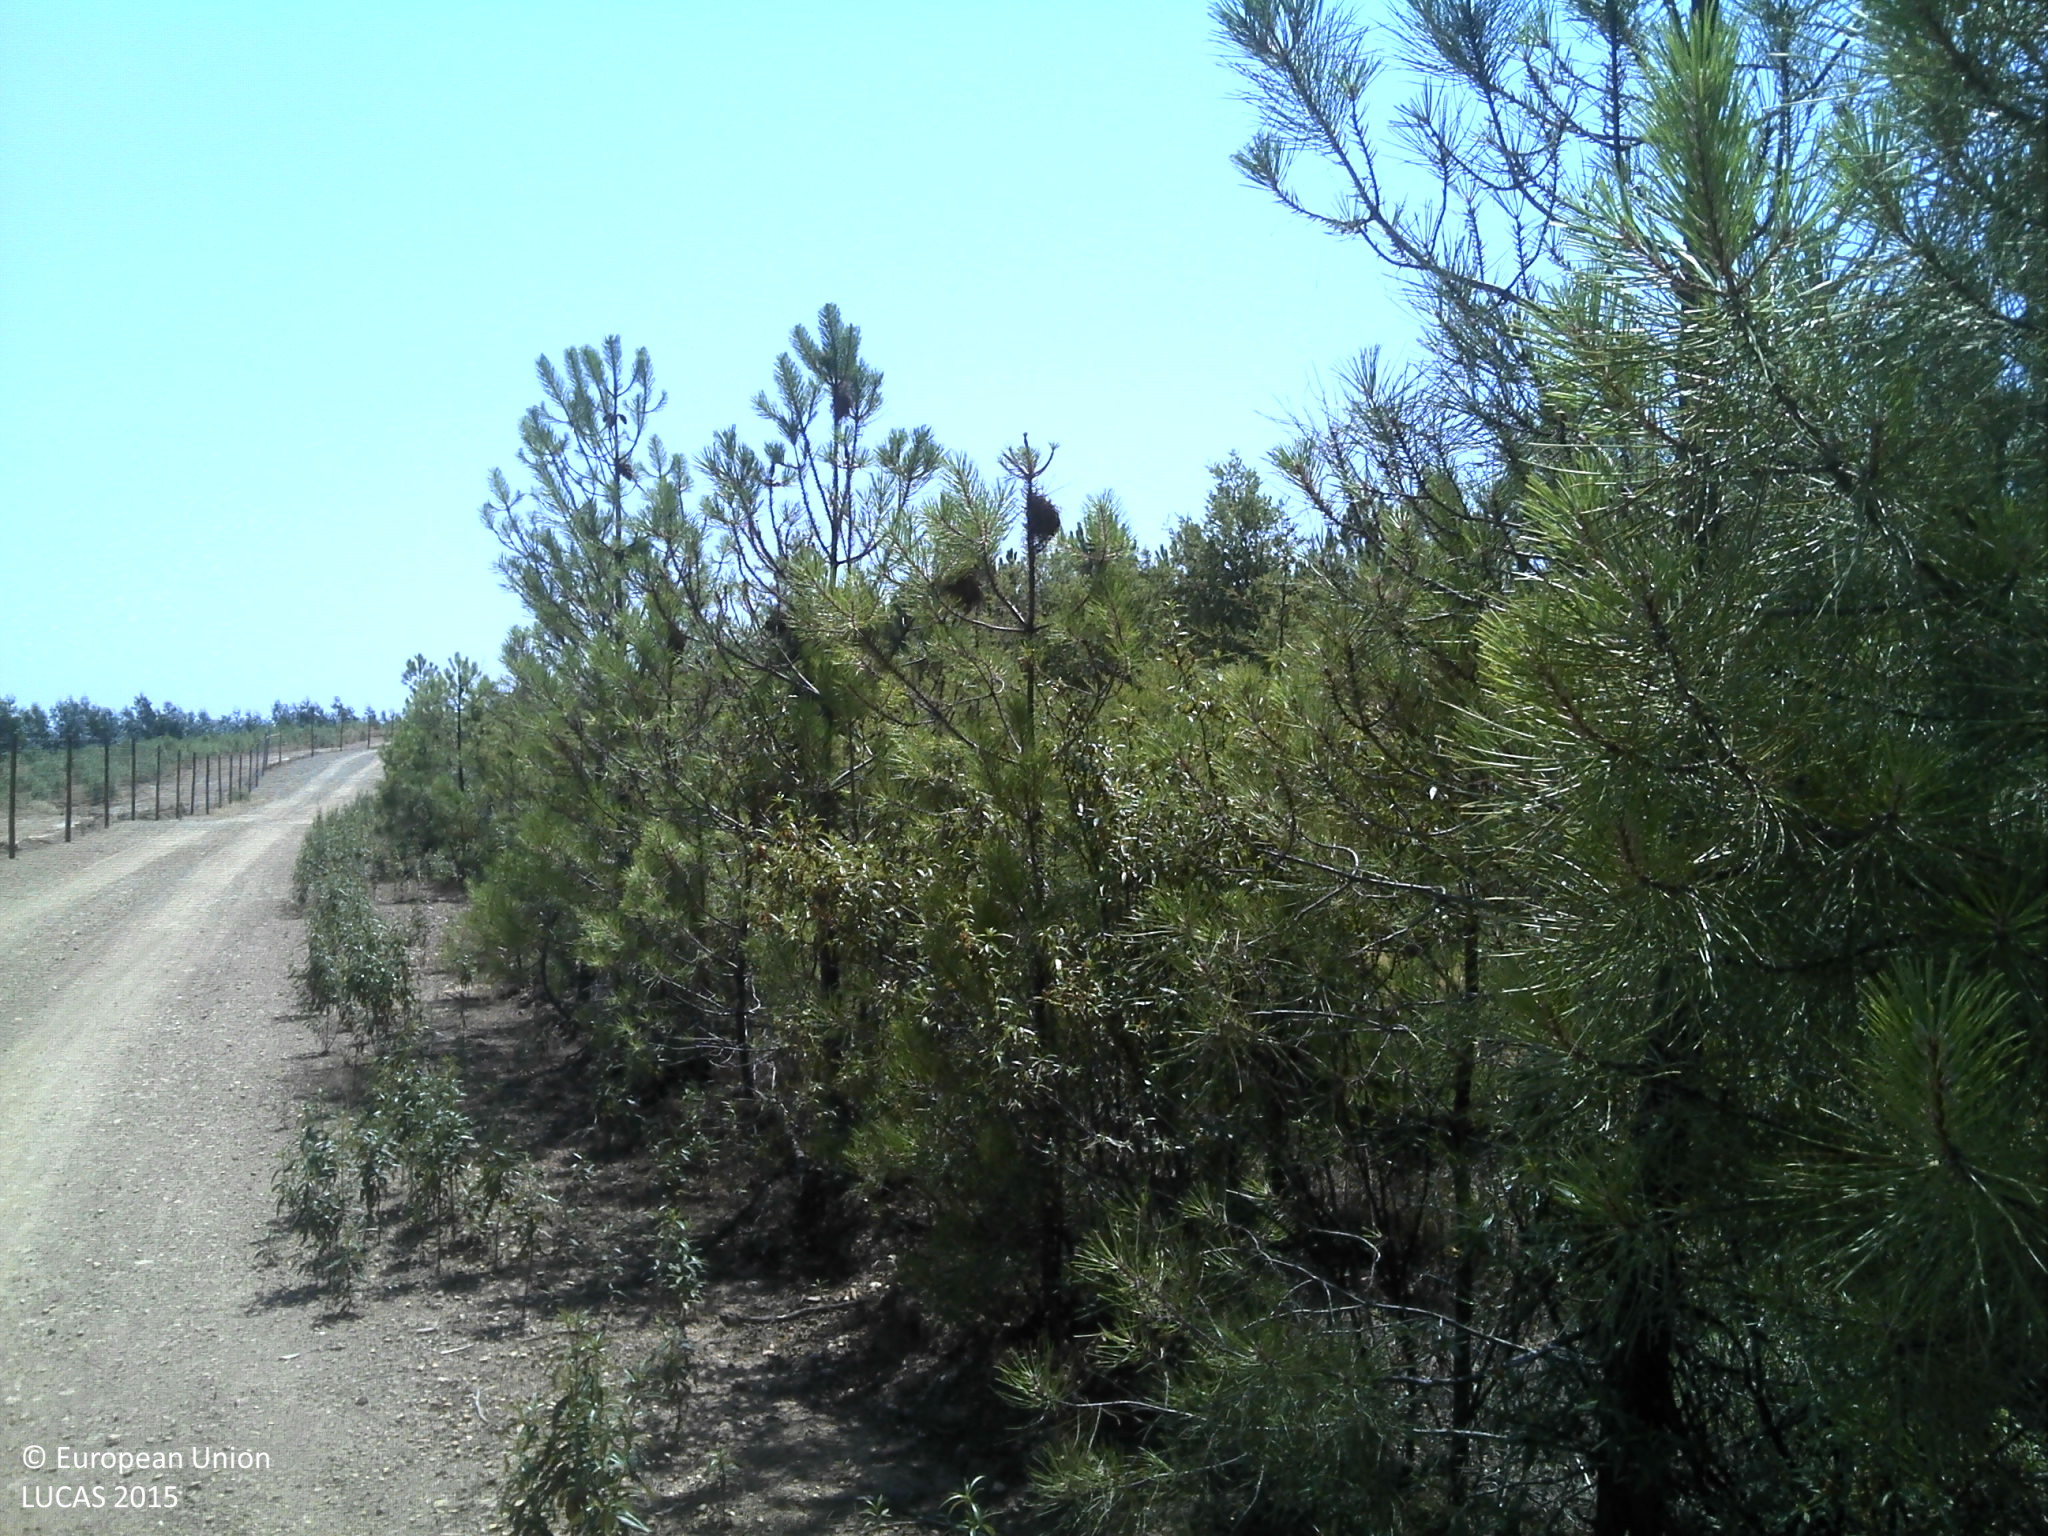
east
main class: Woodland
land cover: Pine dominated coniferous woodland
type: coniferous forest of the mediterranean region
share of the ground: > 75 %
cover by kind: coniferous forest trees 75 %, unconsolidated bare surface 25 %
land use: Forestry
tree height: > 5 m
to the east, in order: Pine dominated coniferous woodland; Tracks; Pine dominated coniferous woodland
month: June
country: PT
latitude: 40.0781
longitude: -7.0137
